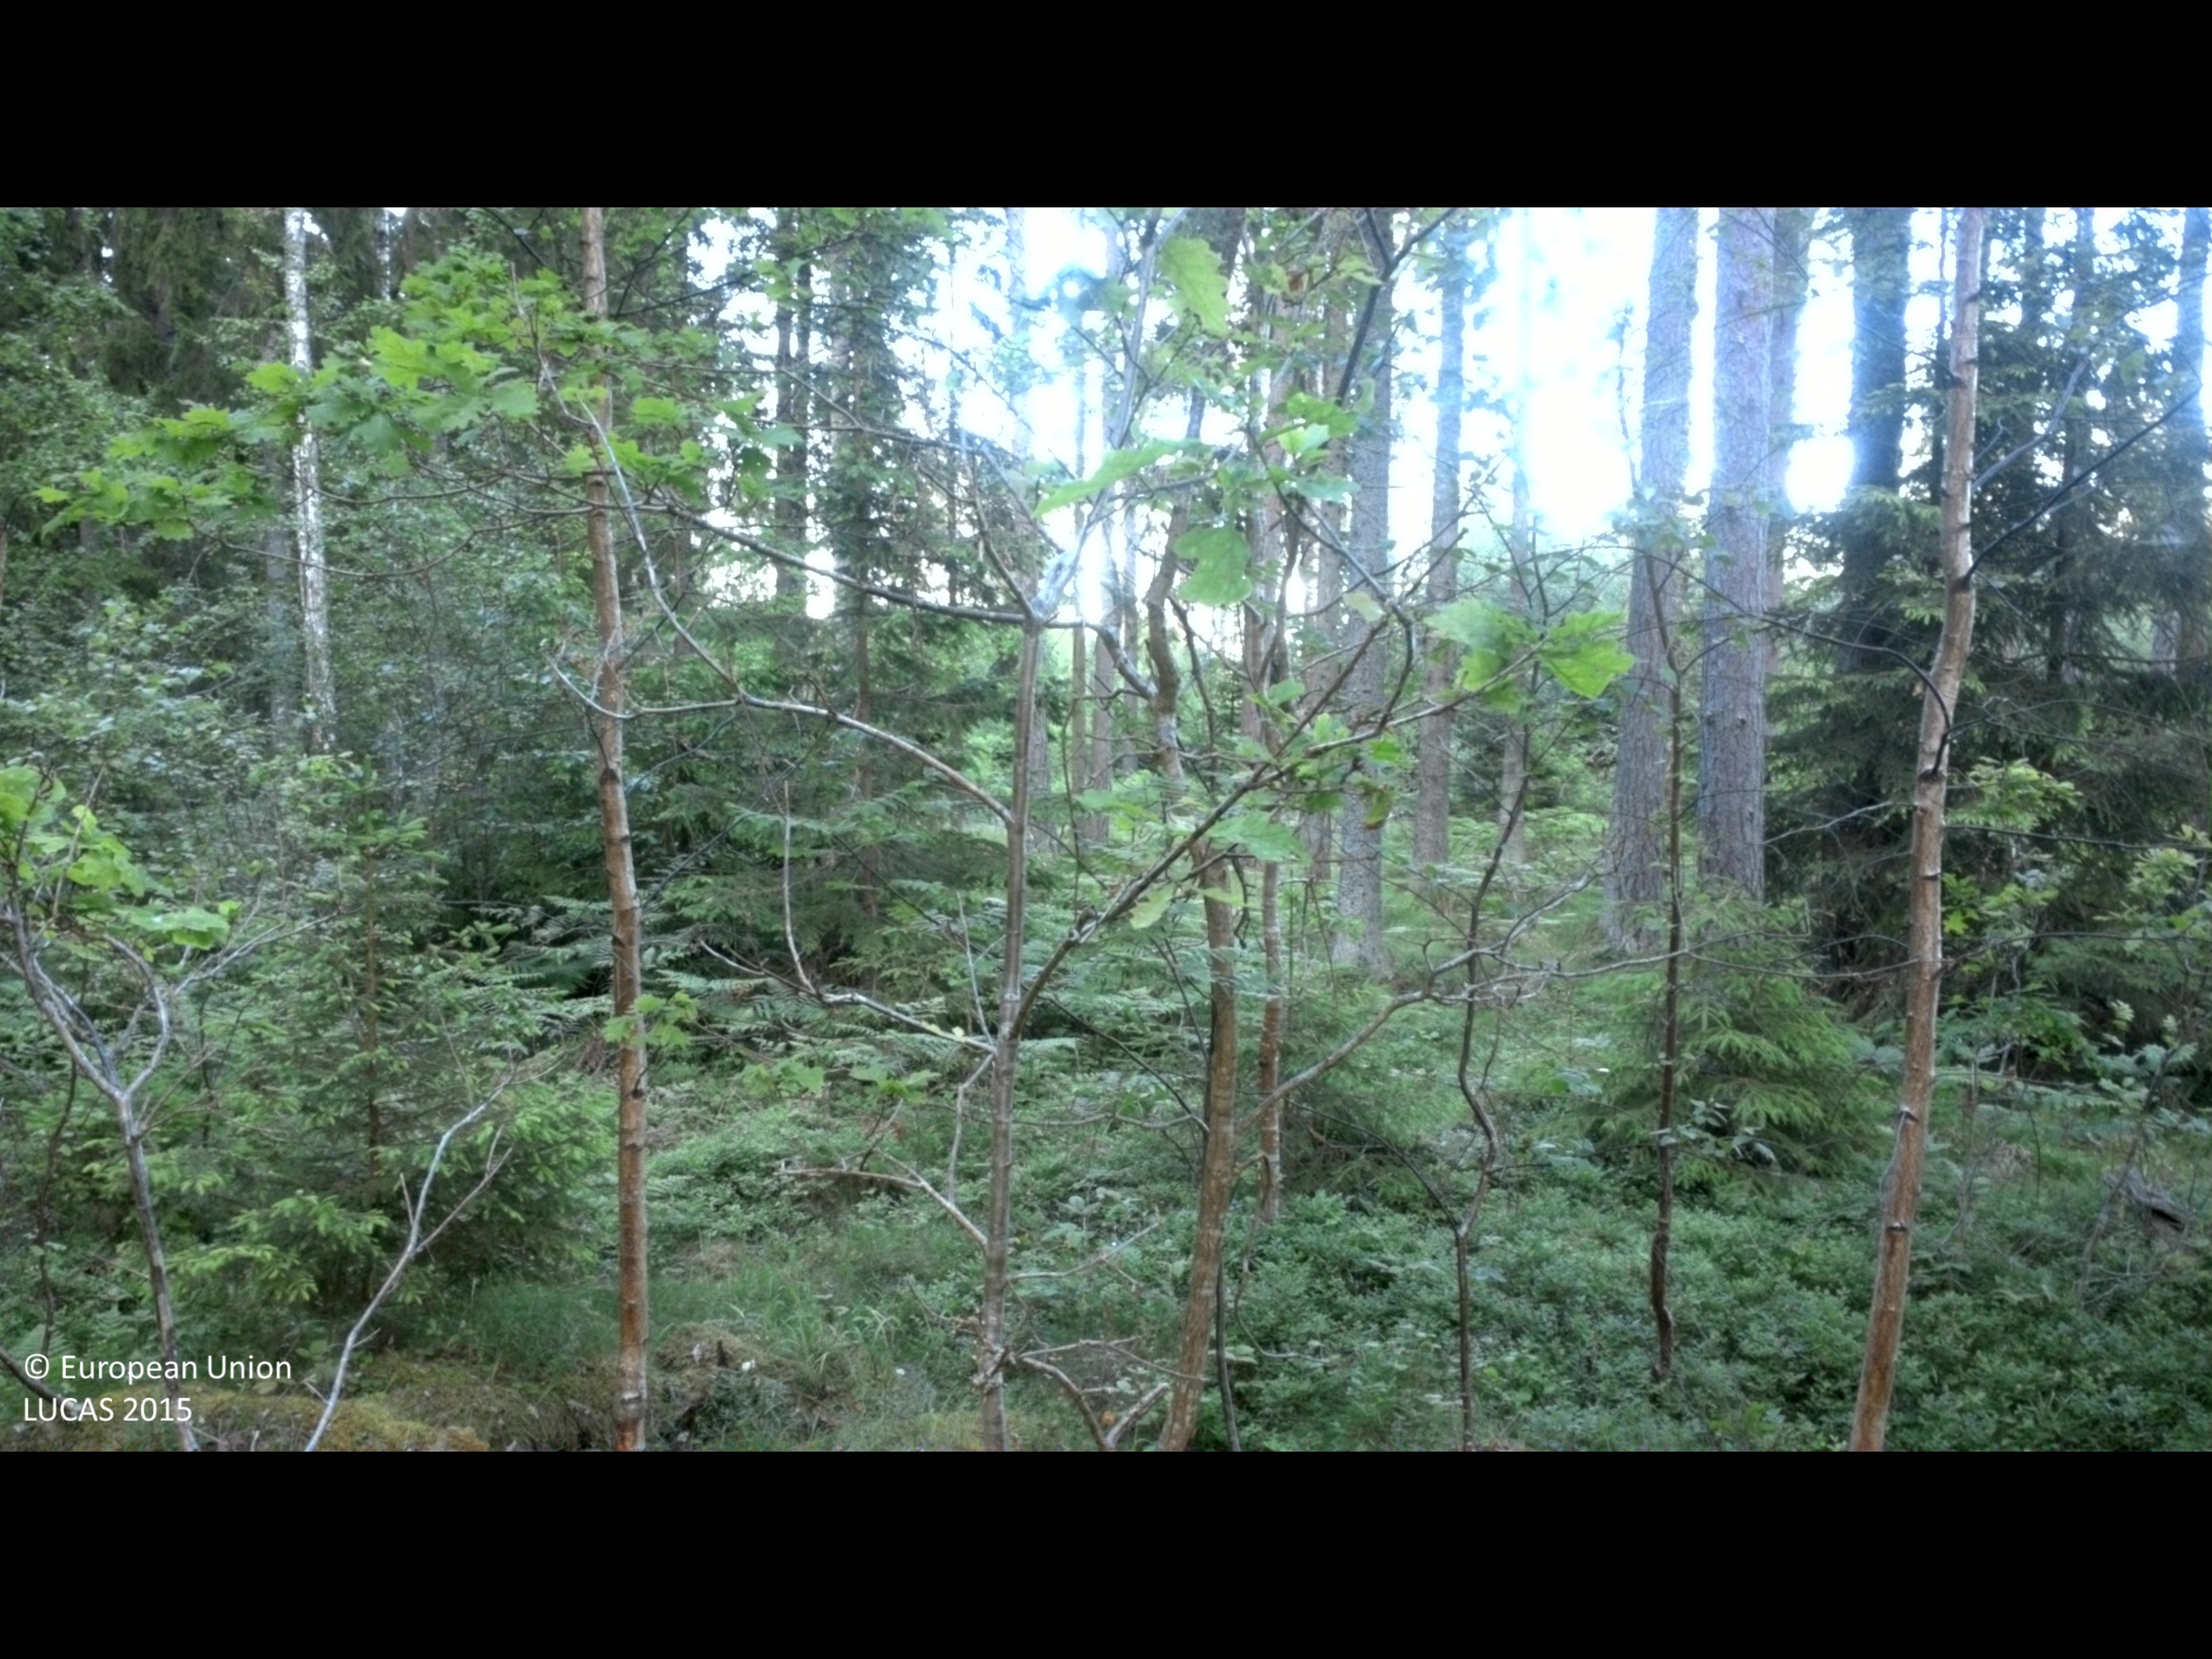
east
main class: Woodland
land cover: Pine dominated mixed woodland
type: hemiboreal forest and nemoral coniferous forest and mixed broadleaved-coniferous forest
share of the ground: > 75 %
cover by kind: coniferous forest trees 60 %, broadleaved forest trees 20 %, shrubs 15 %, herbaceous plants 5 %
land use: Forestry
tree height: > 5 m
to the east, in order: Pine dominated mixed woodland; Other mixed woodland; Broadleaved woodland; Fences; Grassland with sparse tree/shrub cover; Grassland without tree/shrub cover; Ditches and canals; Broadleaved woodland
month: June
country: SE
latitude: 57.8236
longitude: 16.5816
